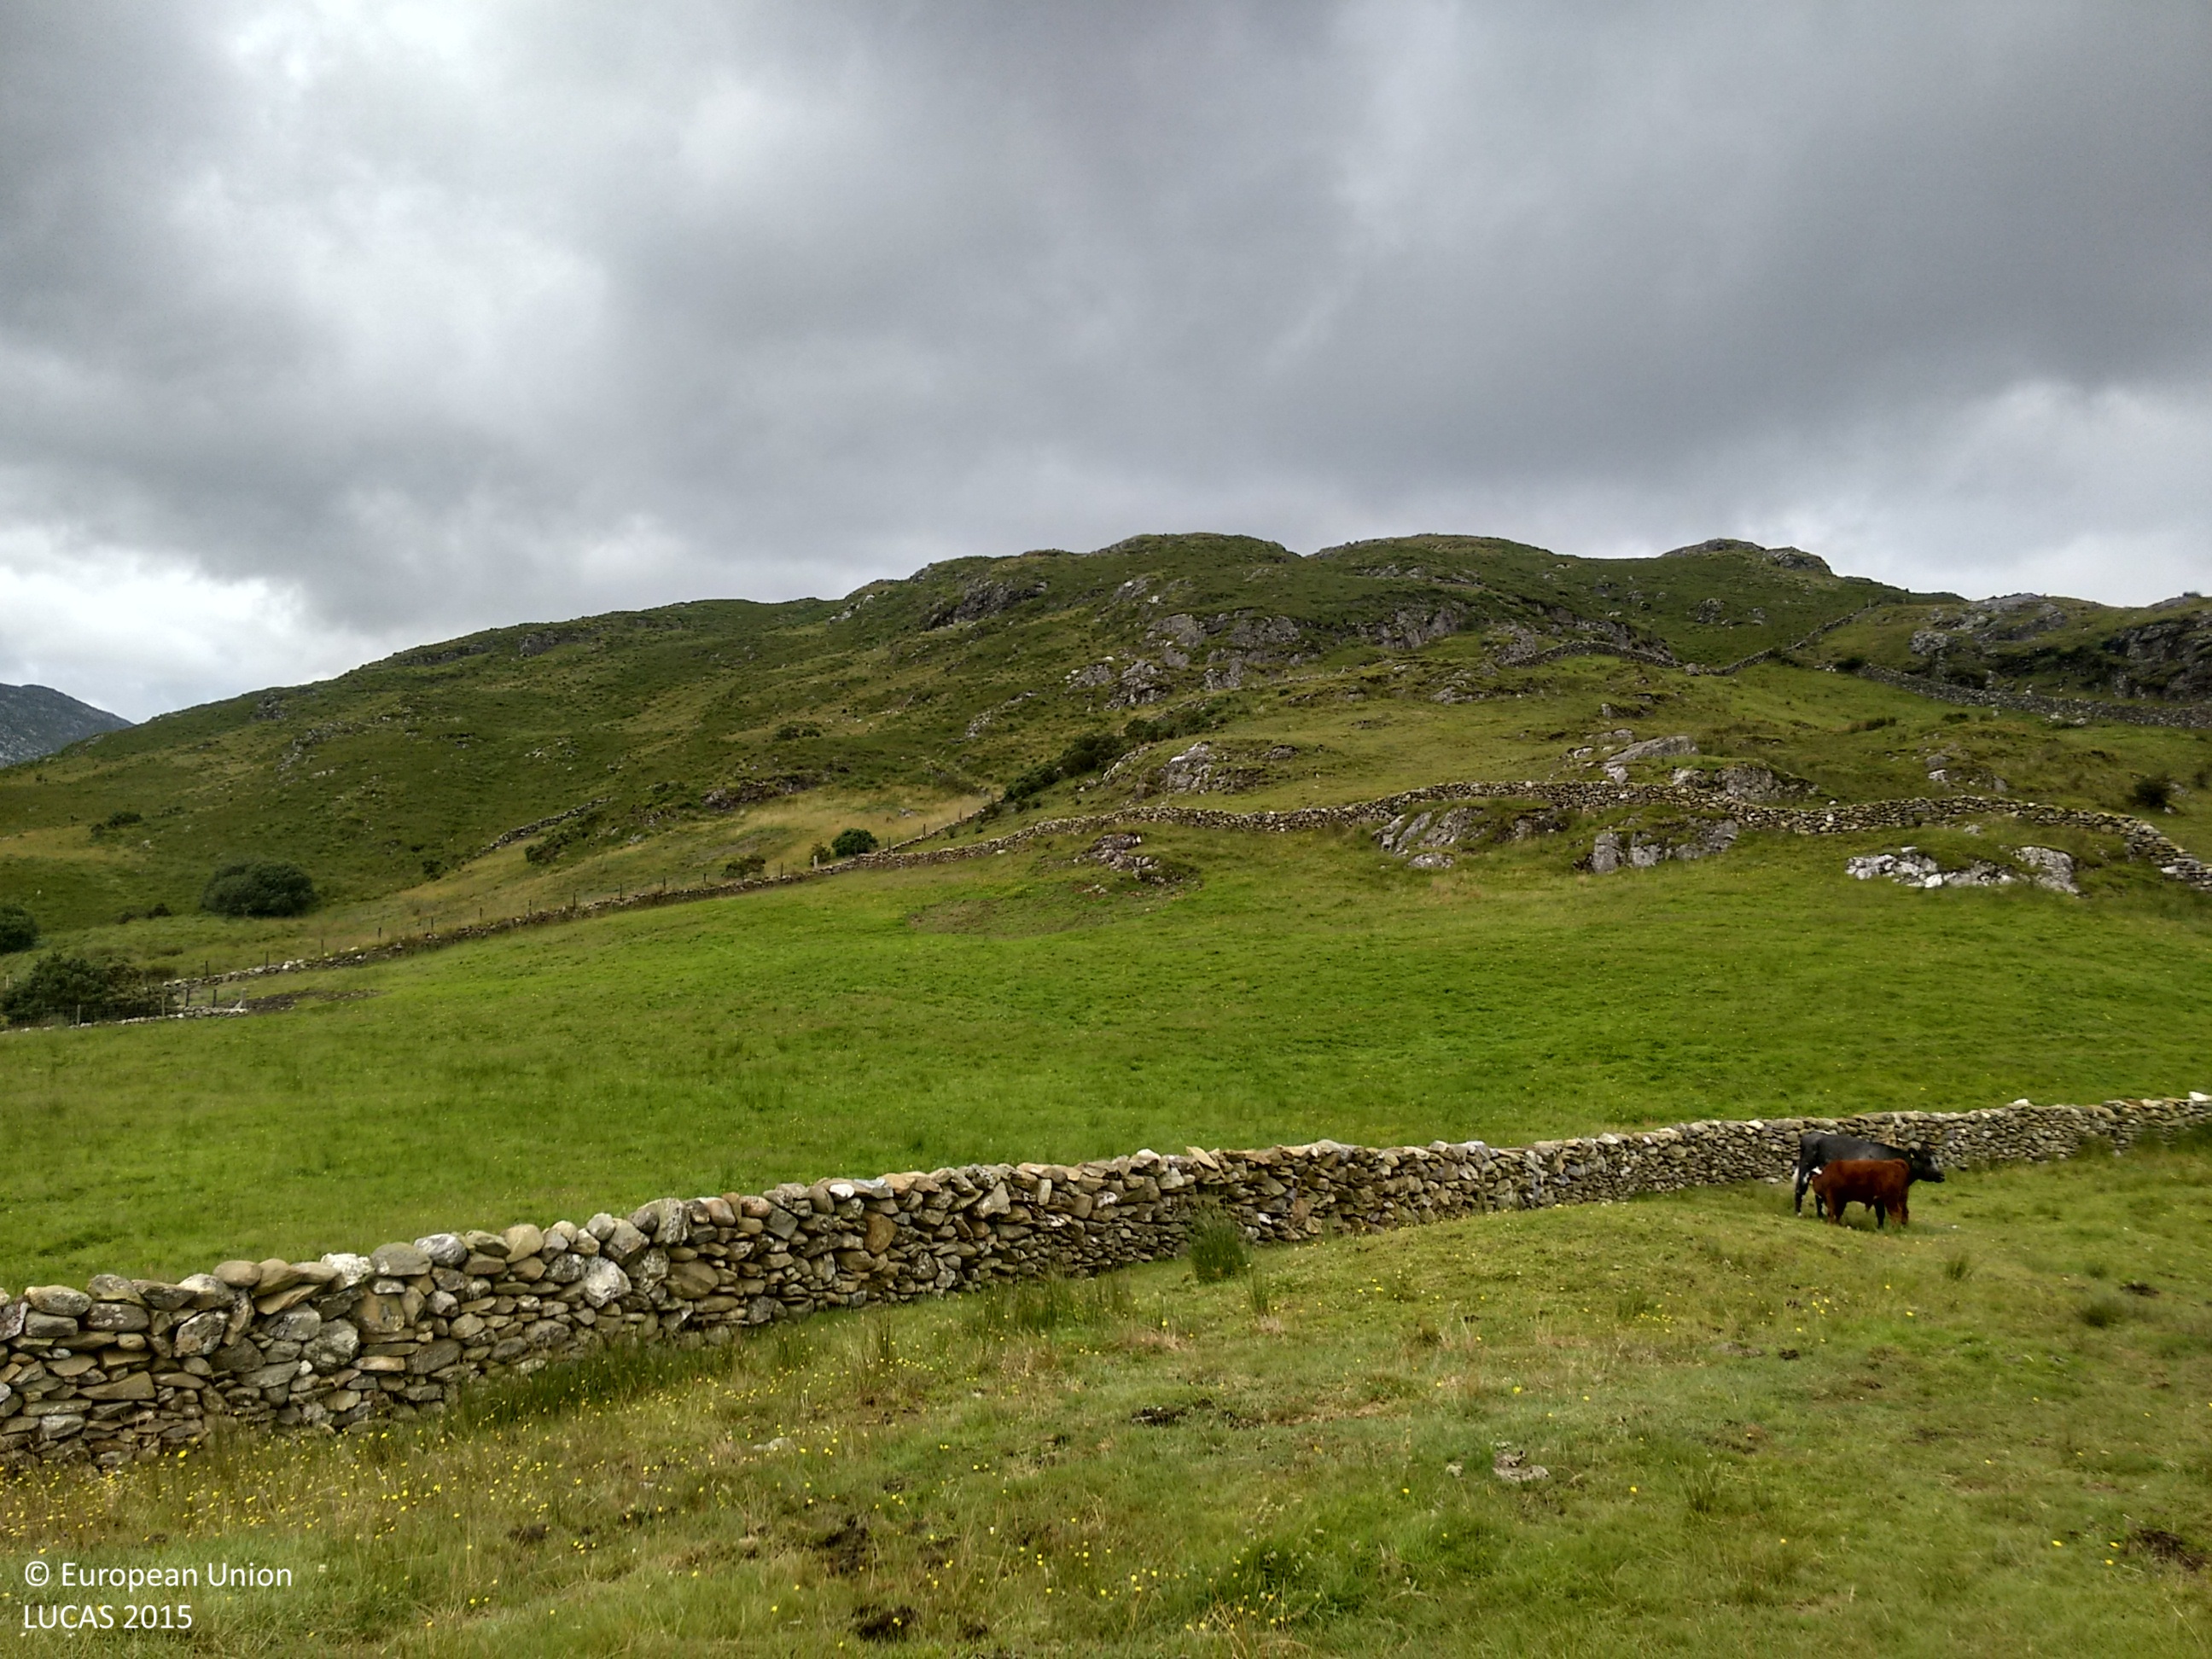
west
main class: Grassland
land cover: Grassland without tree/shrub cover
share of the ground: > 75 %
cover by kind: herbaceous plants 100 %
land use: Agriculture (excluding fallow land and kitchen gardens)
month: July
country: IE
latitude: 53.5013
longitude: -9.4838
